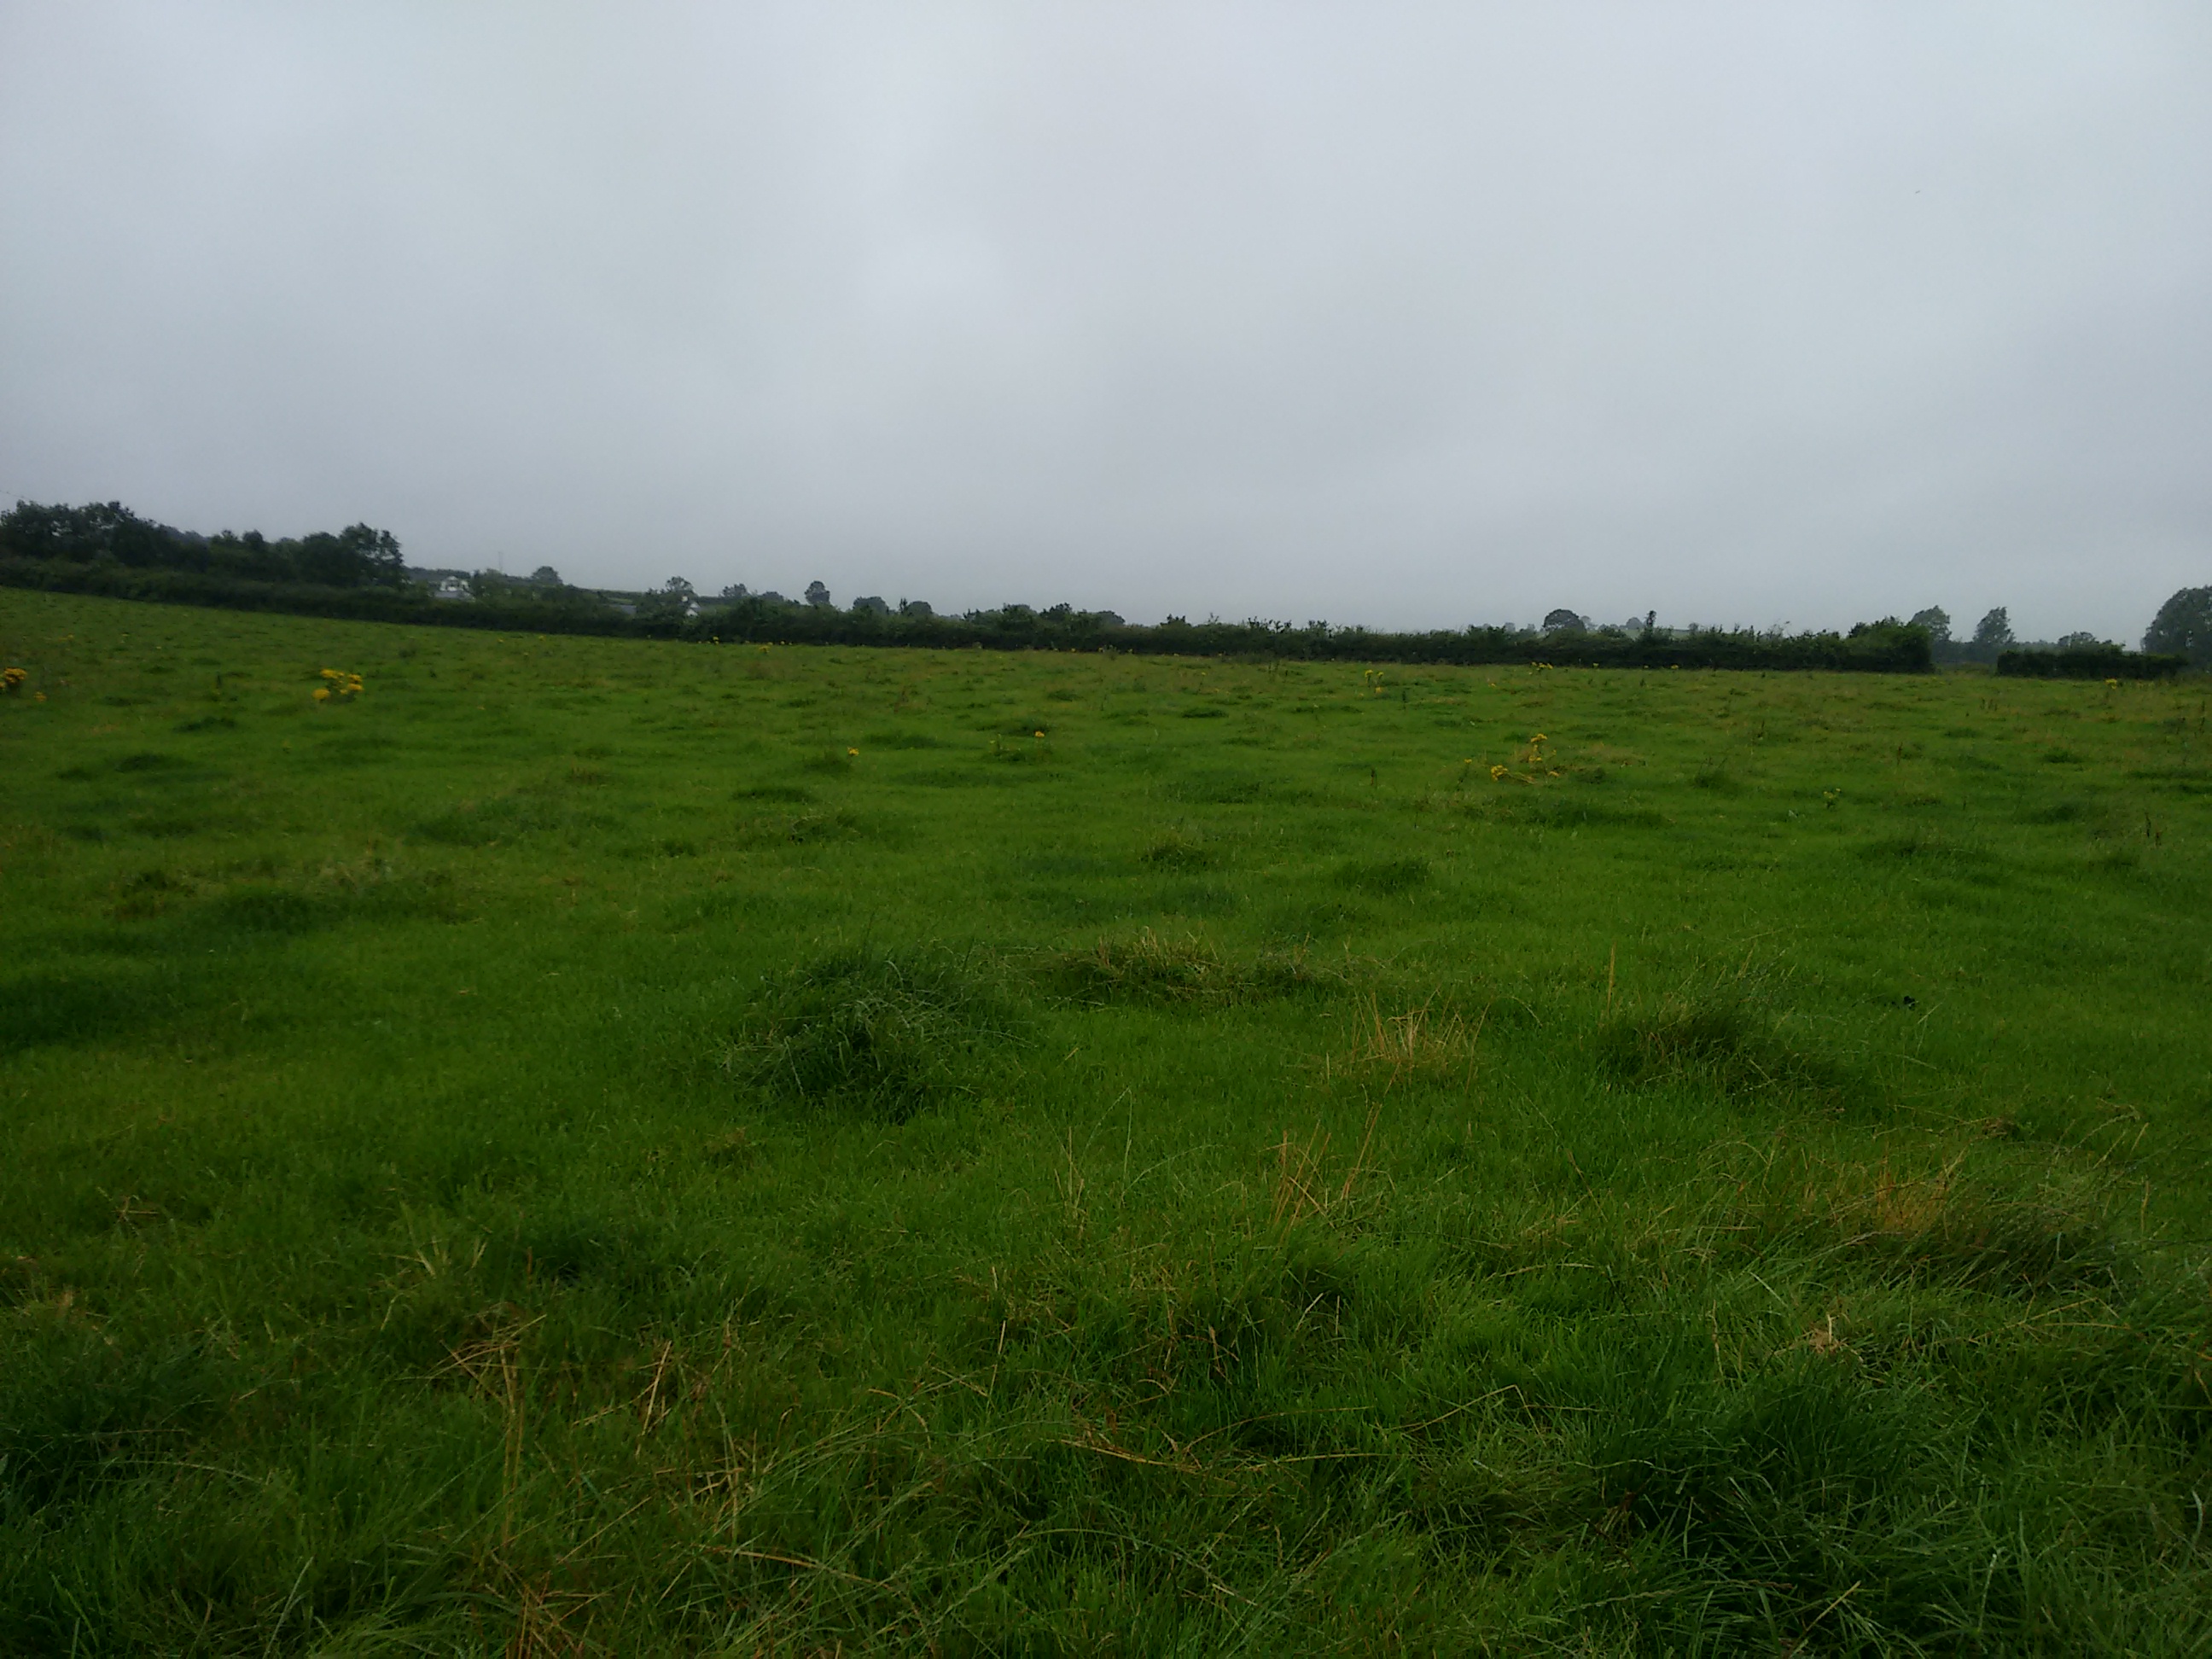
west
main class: Grassland
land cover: Grassland without tree/shrub cover
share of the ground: > 75 %
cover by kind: herbaceous plants 100 %
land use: Agriculture (excluding fallow land and kitchen gardens)
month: August
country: GB
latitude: 54.8609
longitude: -6.5609
